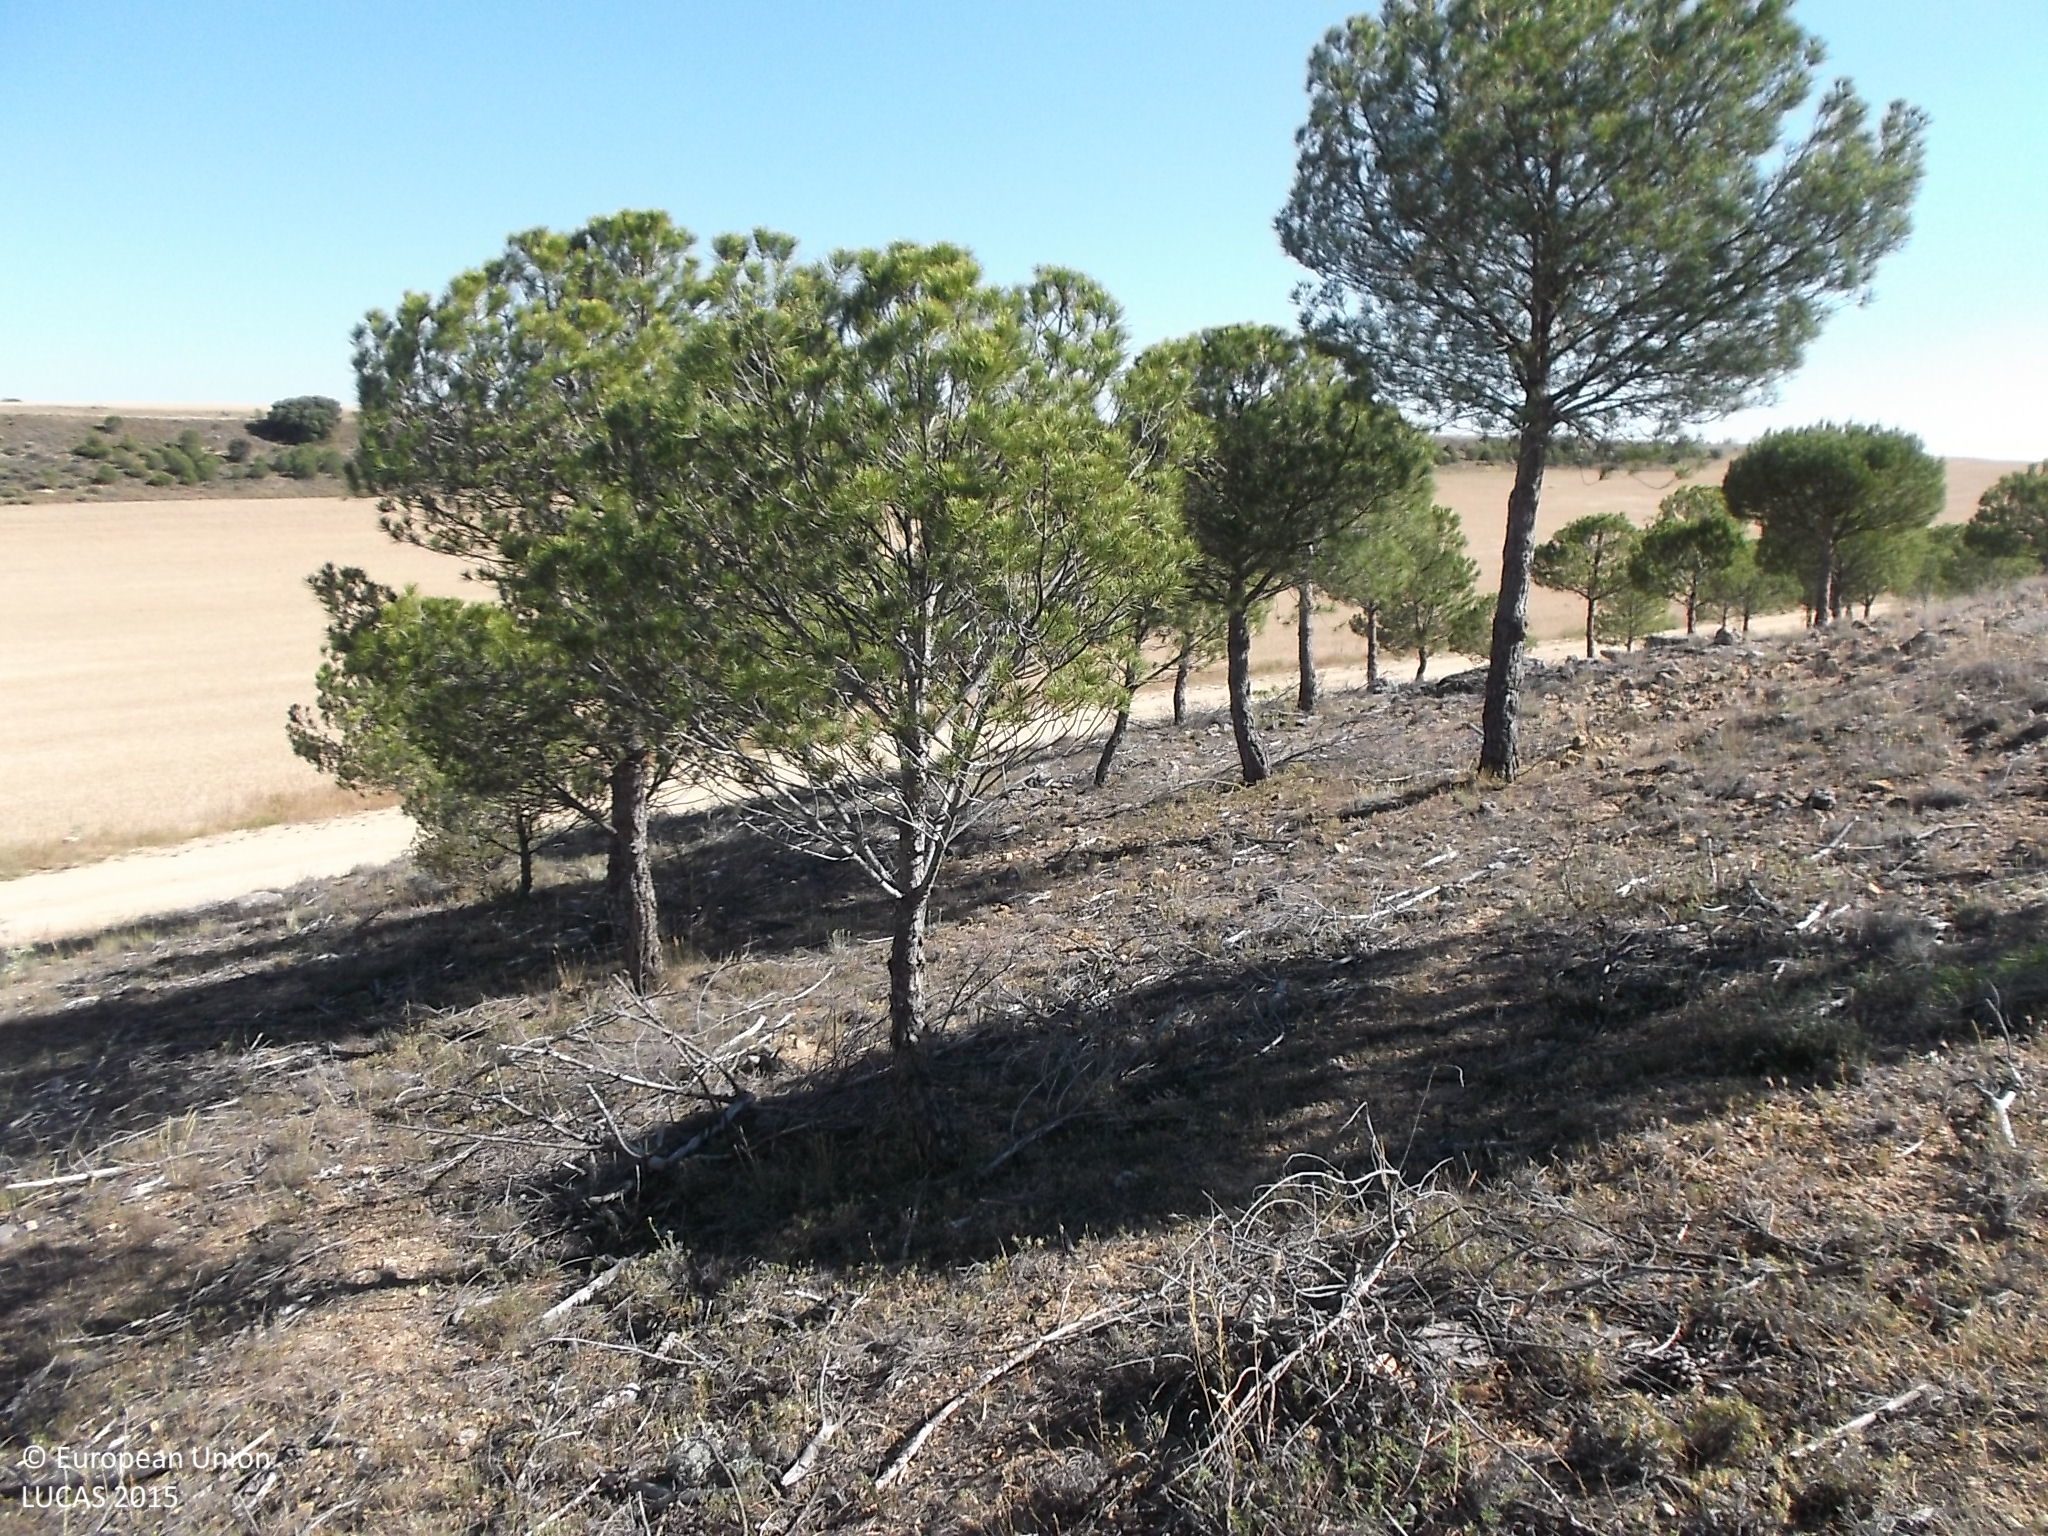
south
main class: Woodland
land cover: Pine dominated coniferous woodland
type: coniferous forest of the mediterranean region
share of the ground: 25 - 50 %
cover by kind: herbaceous plants 65 %, coniferous forest trees 35 %
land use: Forestry
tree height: < 5 m
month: June
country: ES
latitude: 41.3175
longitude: -5.3064
